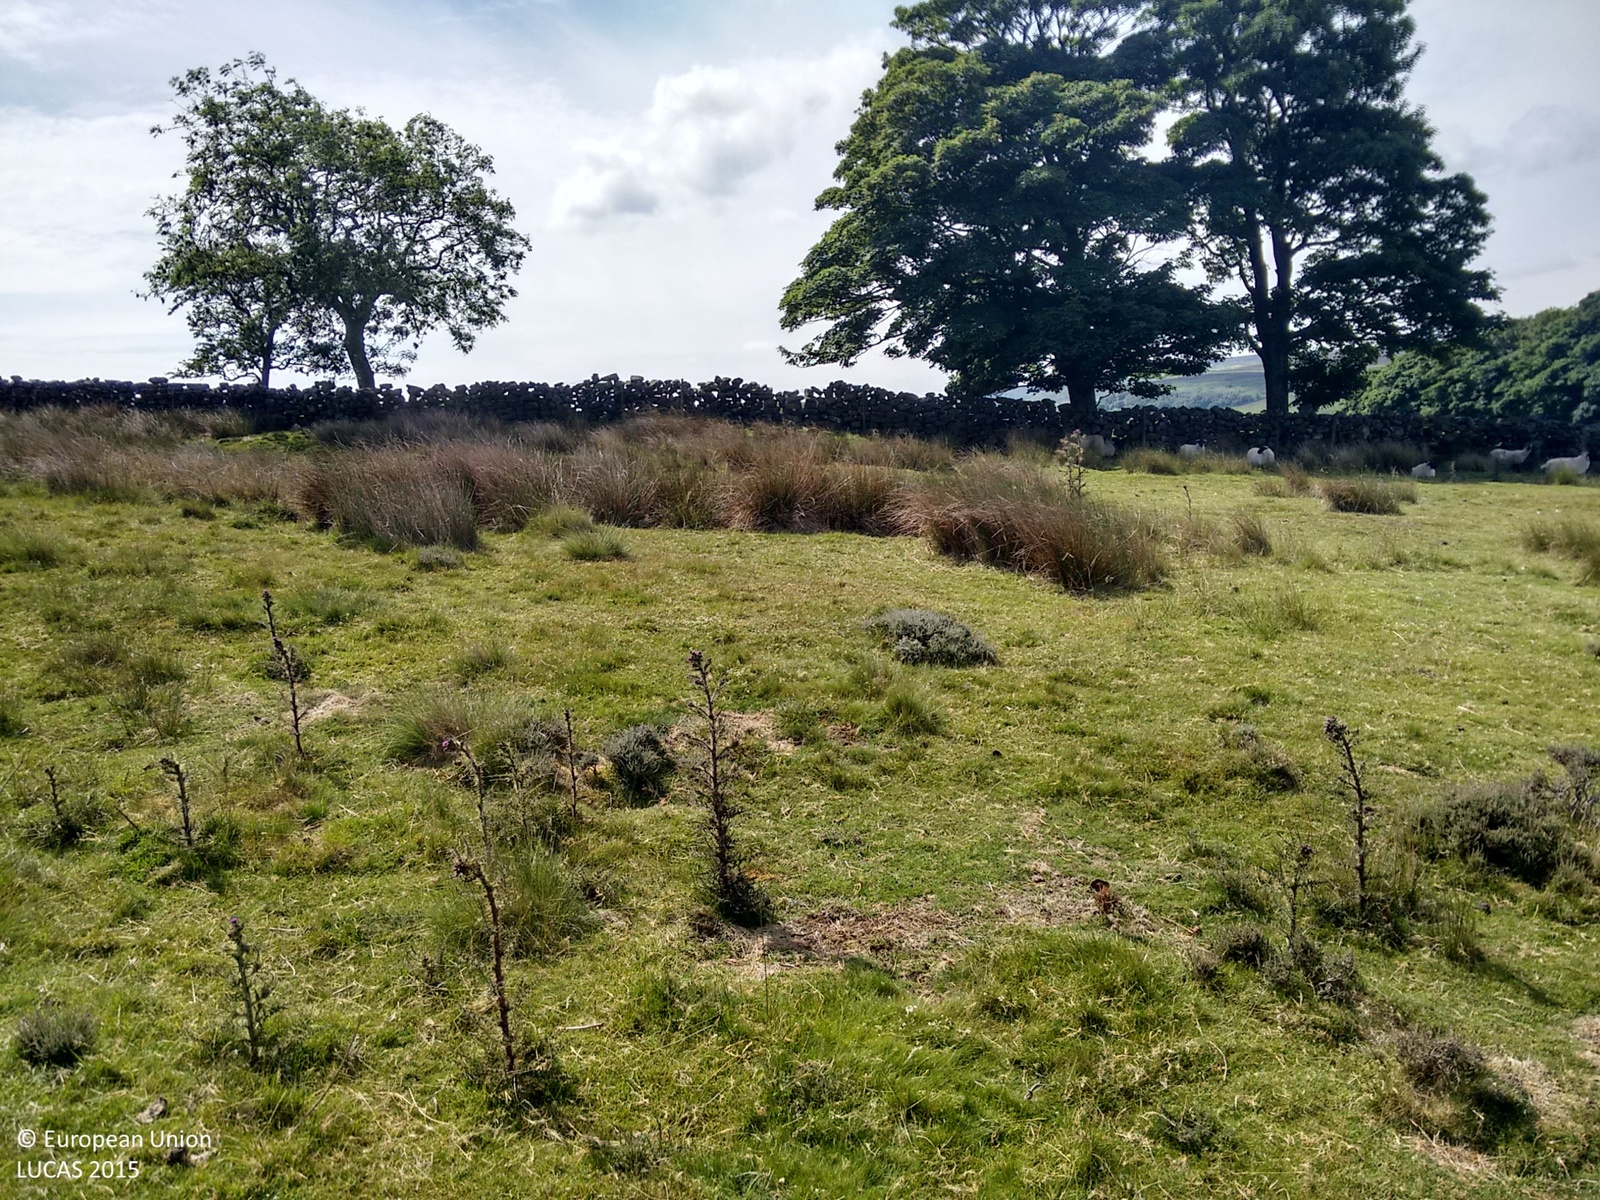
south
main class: Shrubland
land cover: Shrubland without tree cover
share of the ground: > 75 %
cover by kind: shrubs 60 %, herbaceous plants 40 %
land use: Agriculture (excluding fallow land and kitchen gardens)
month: July
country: GB
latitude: 54.4703
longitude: -0.8878
